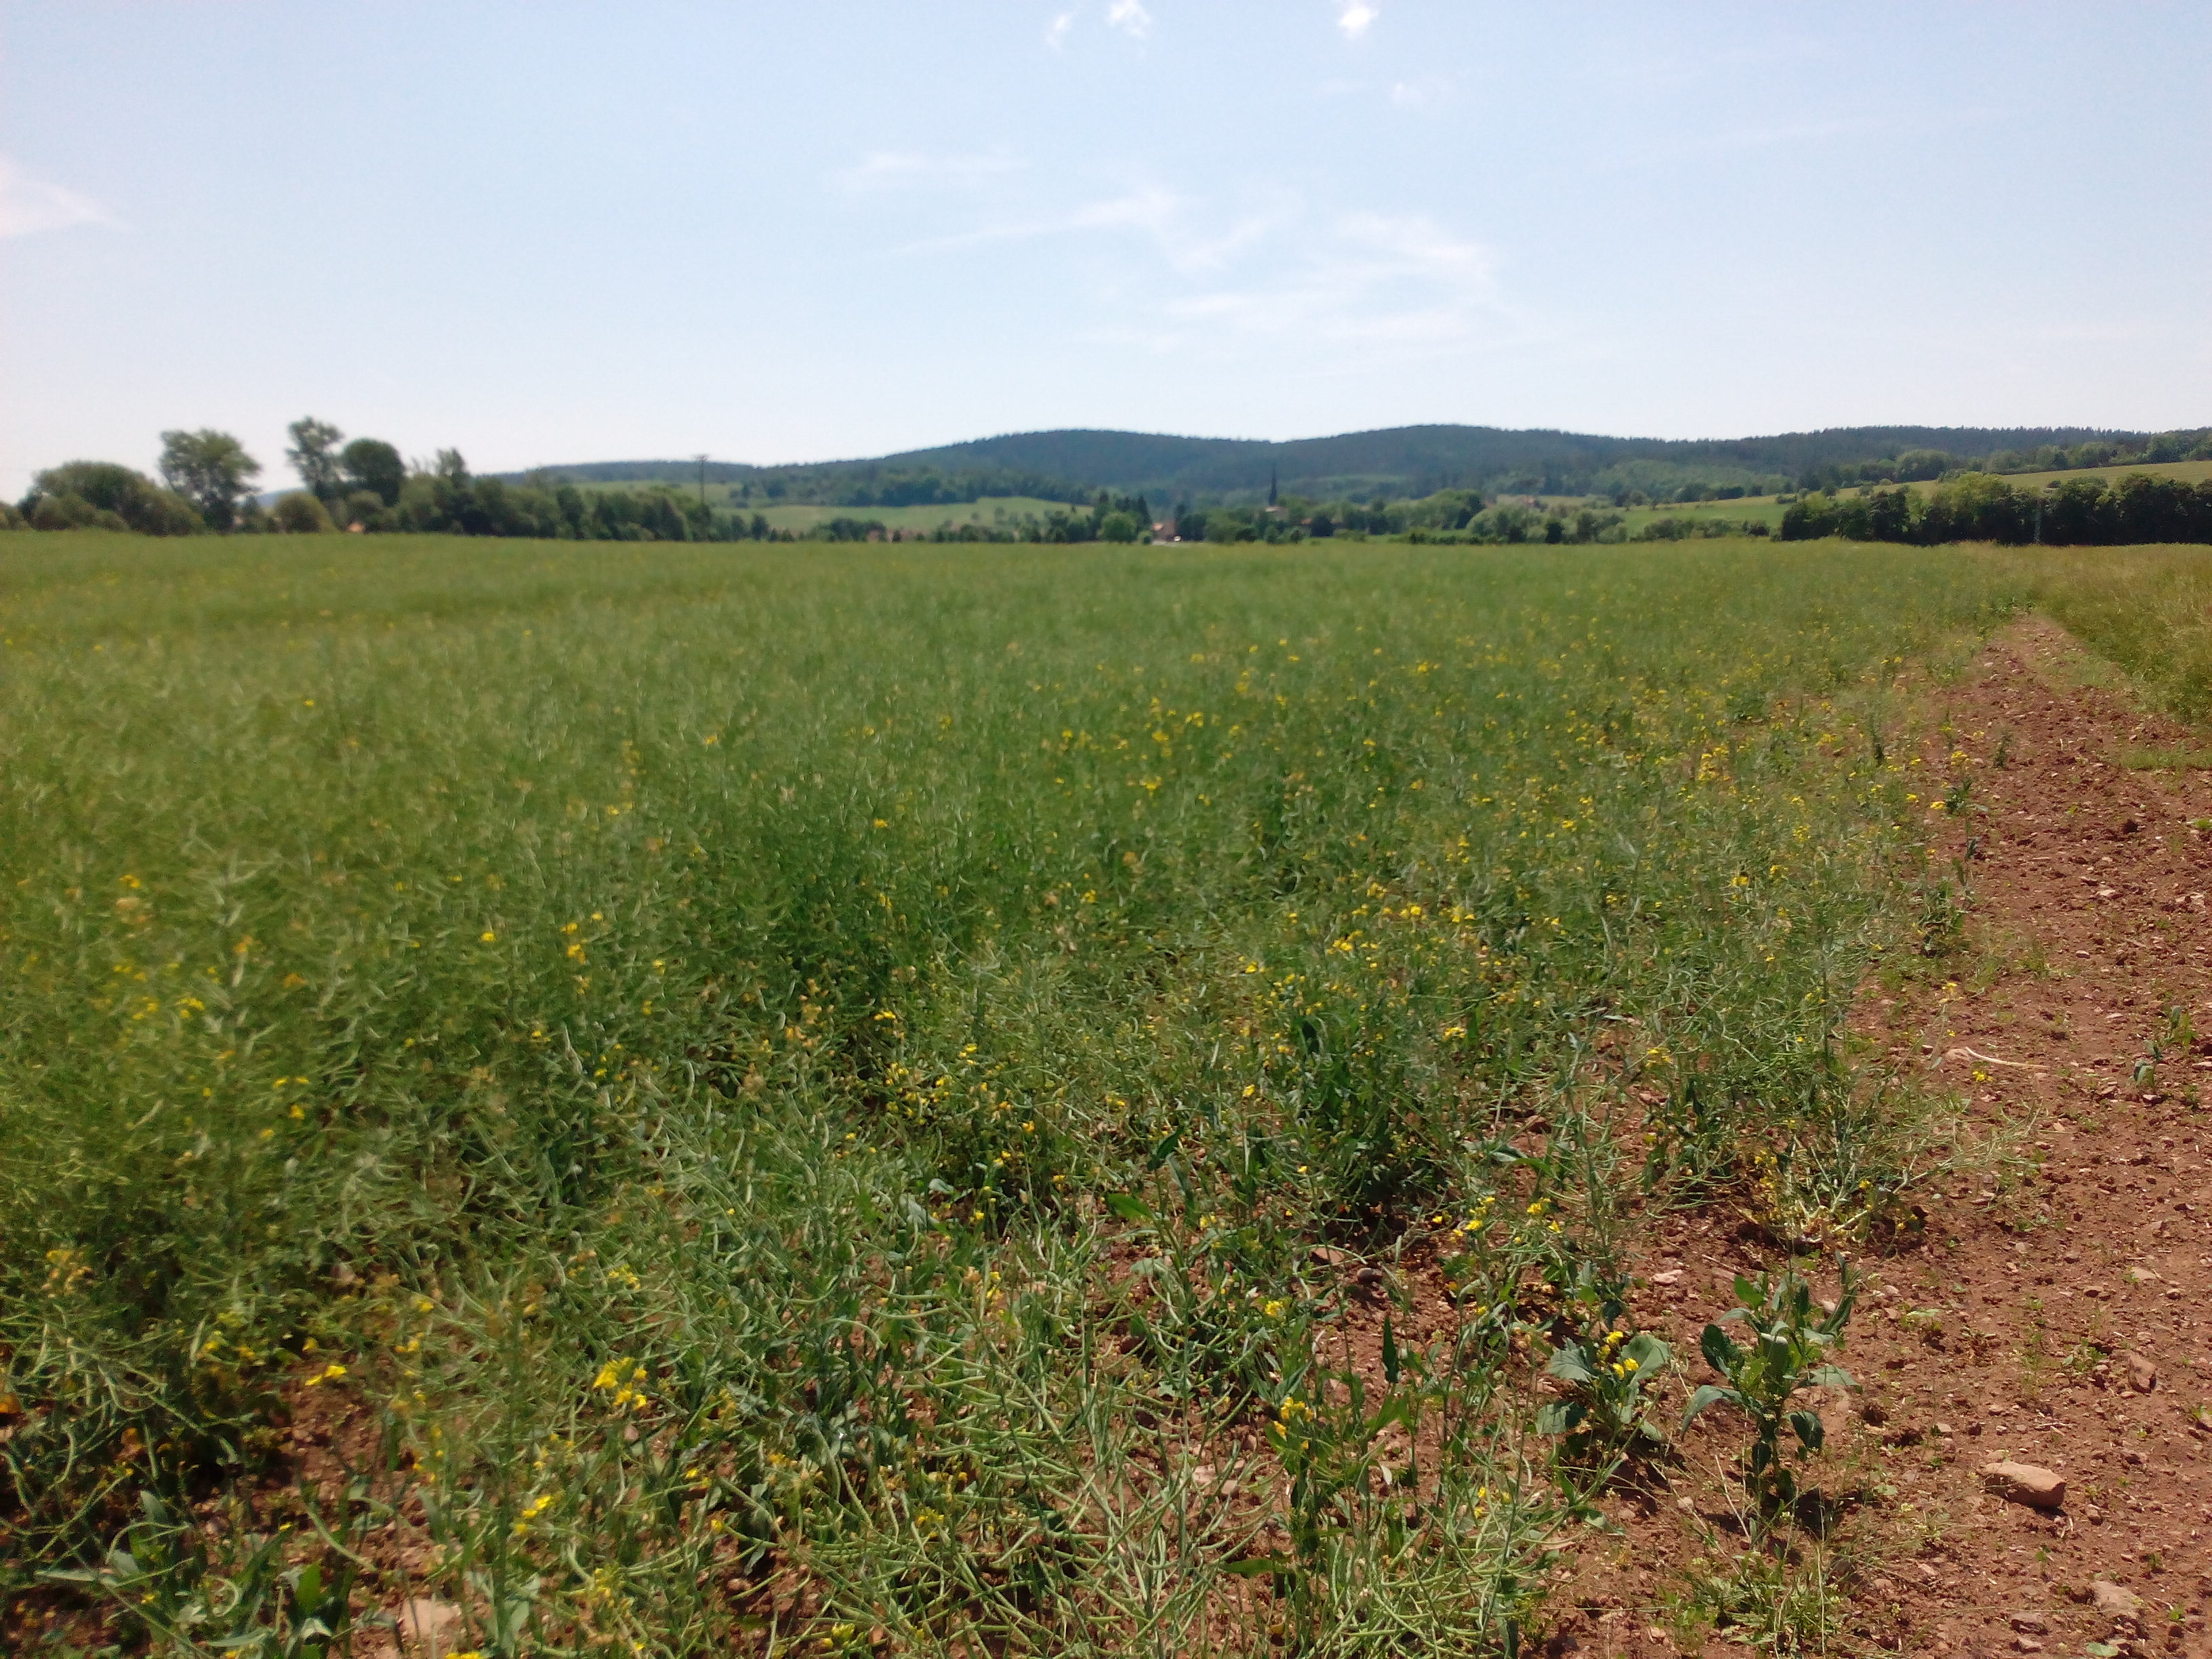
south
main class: Cropland
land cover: Rape and turnip rape
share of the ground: > 75 %
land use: Agriculture (excluding fallow land and kitchen gardens)
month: June
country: DE
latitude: 50.8657
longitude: 10.6392
